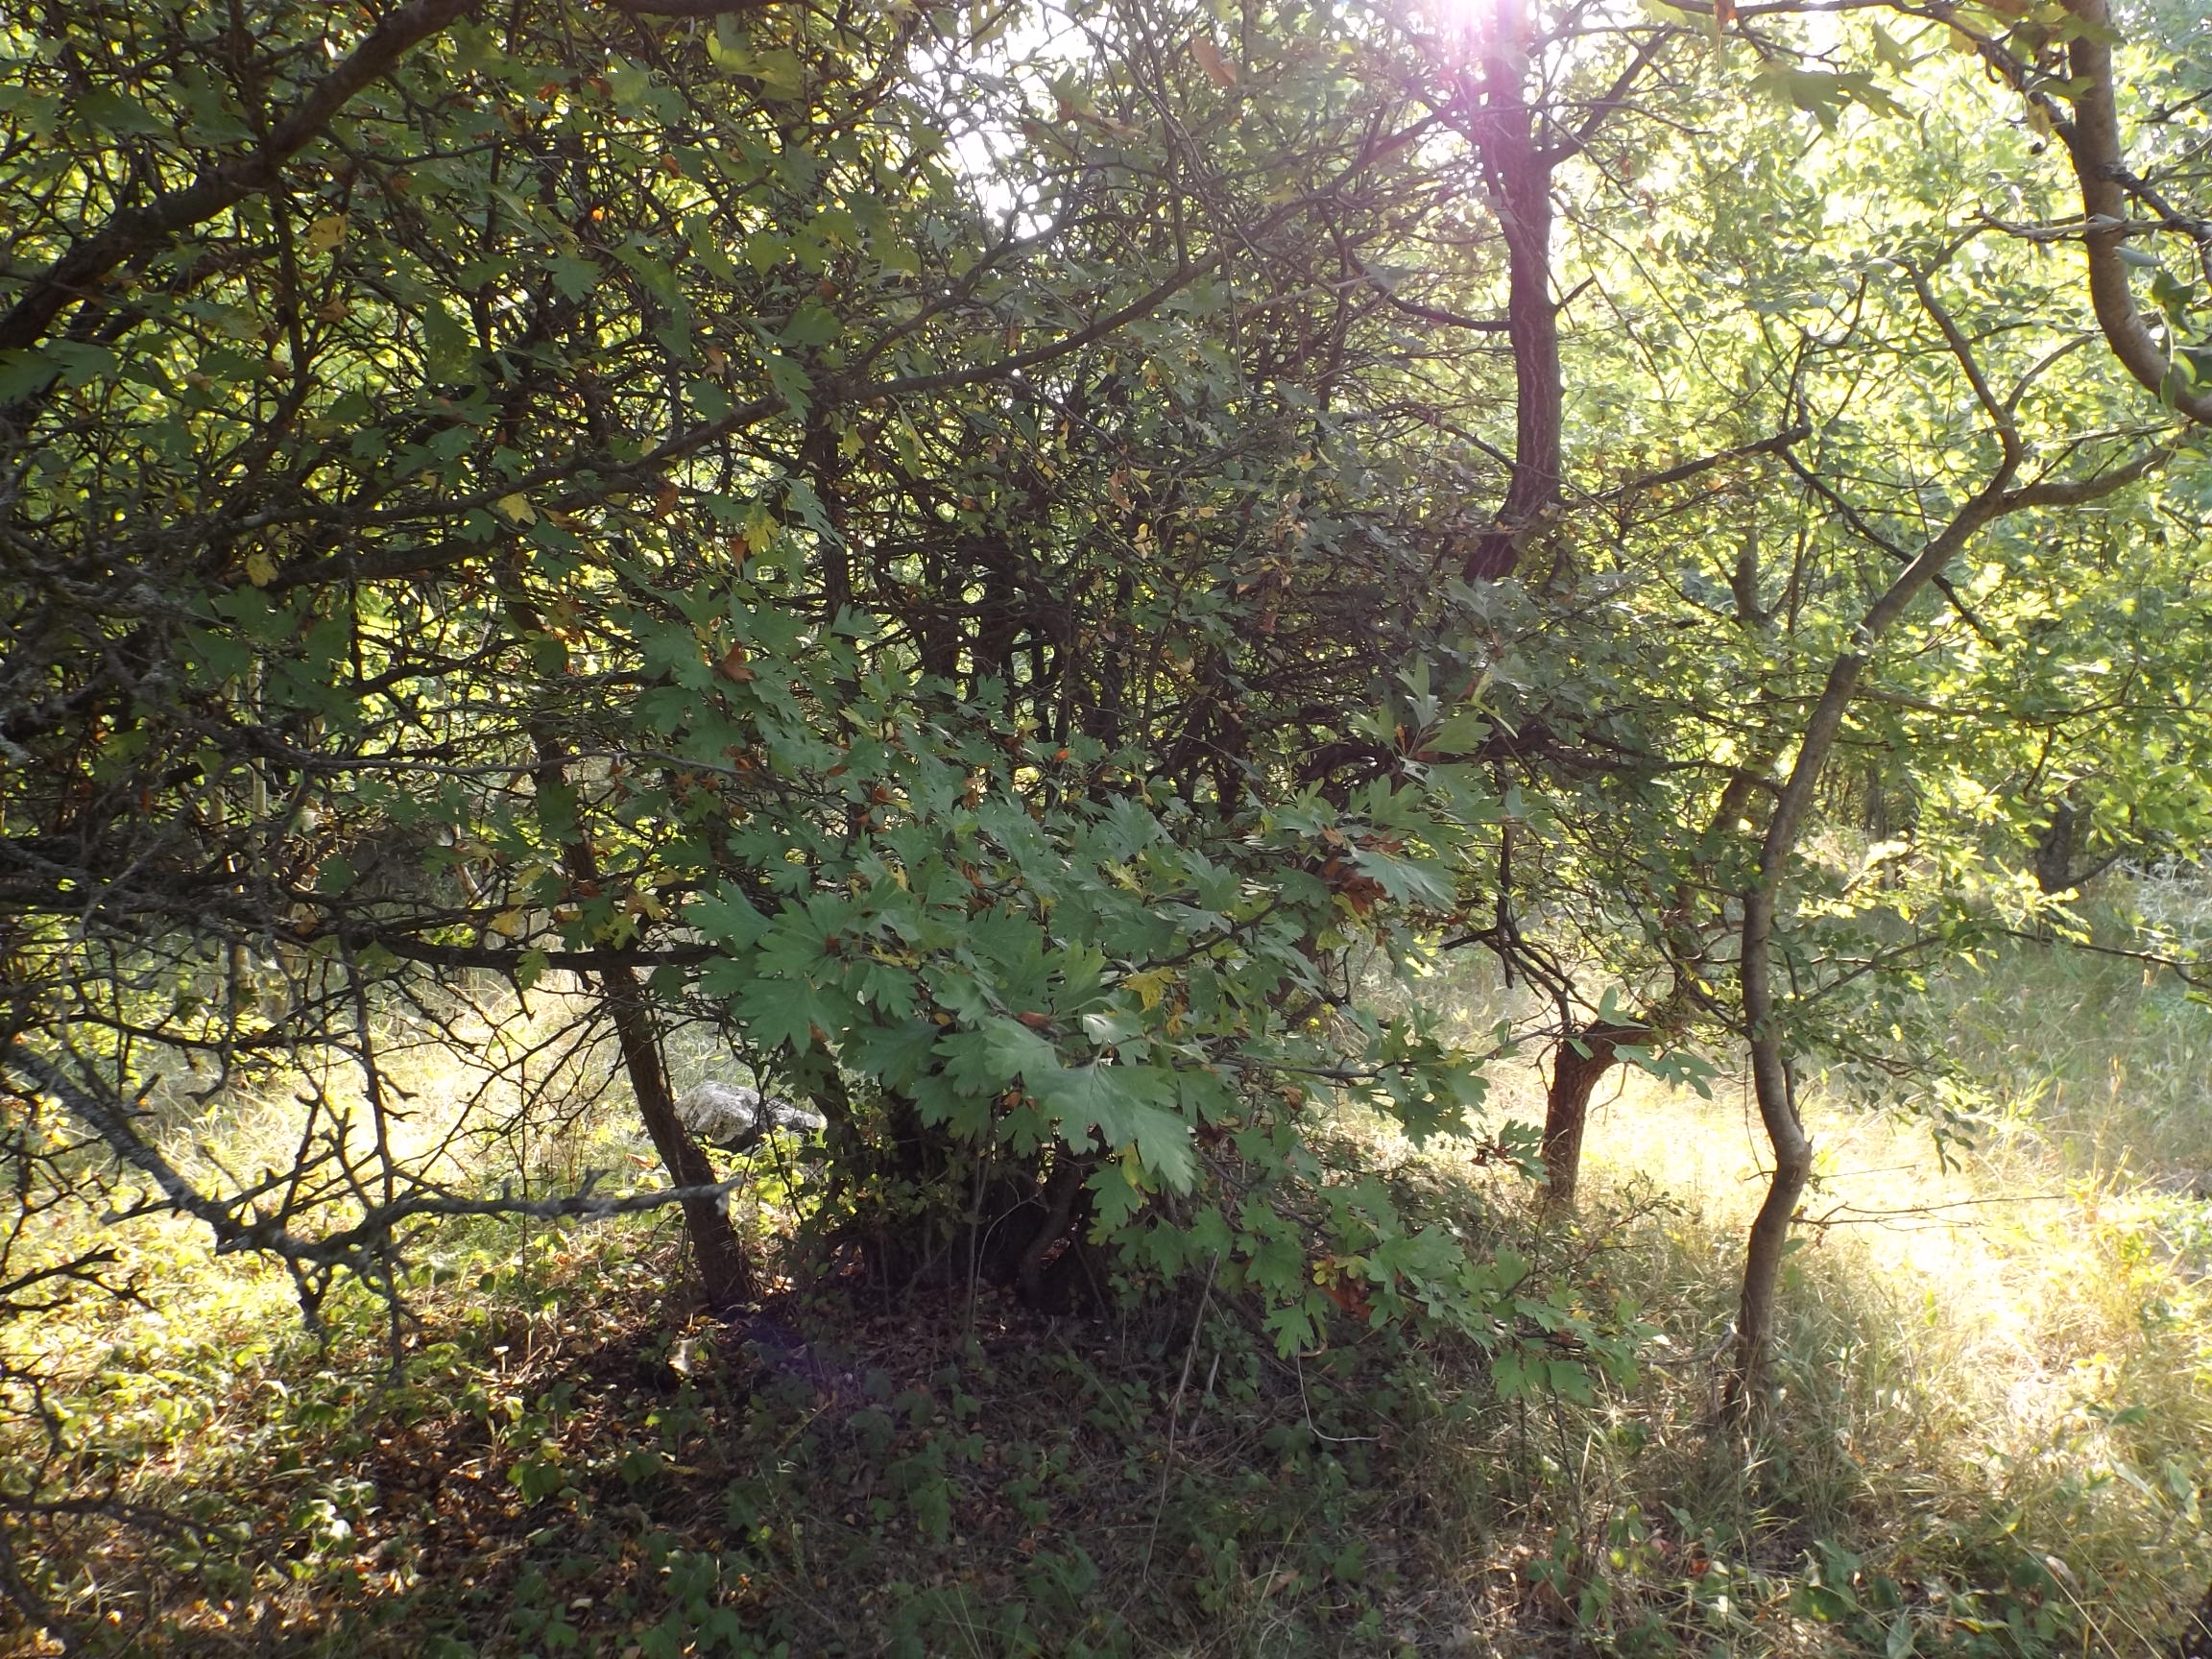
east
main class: Woodland
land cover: Broadleaved woodland
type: mesophytic deciduous forest
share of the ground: 50 - 75 %
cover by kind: broadleaved forest trees 60 %, herbaceous plants 30 %, shrubs 10 %
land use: Forestry
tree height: > 5 m
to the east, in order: Broadleaved woodland; Grassland without tree/shrub cover
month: July
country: BG
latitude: 43.4938
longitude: 27.6075
